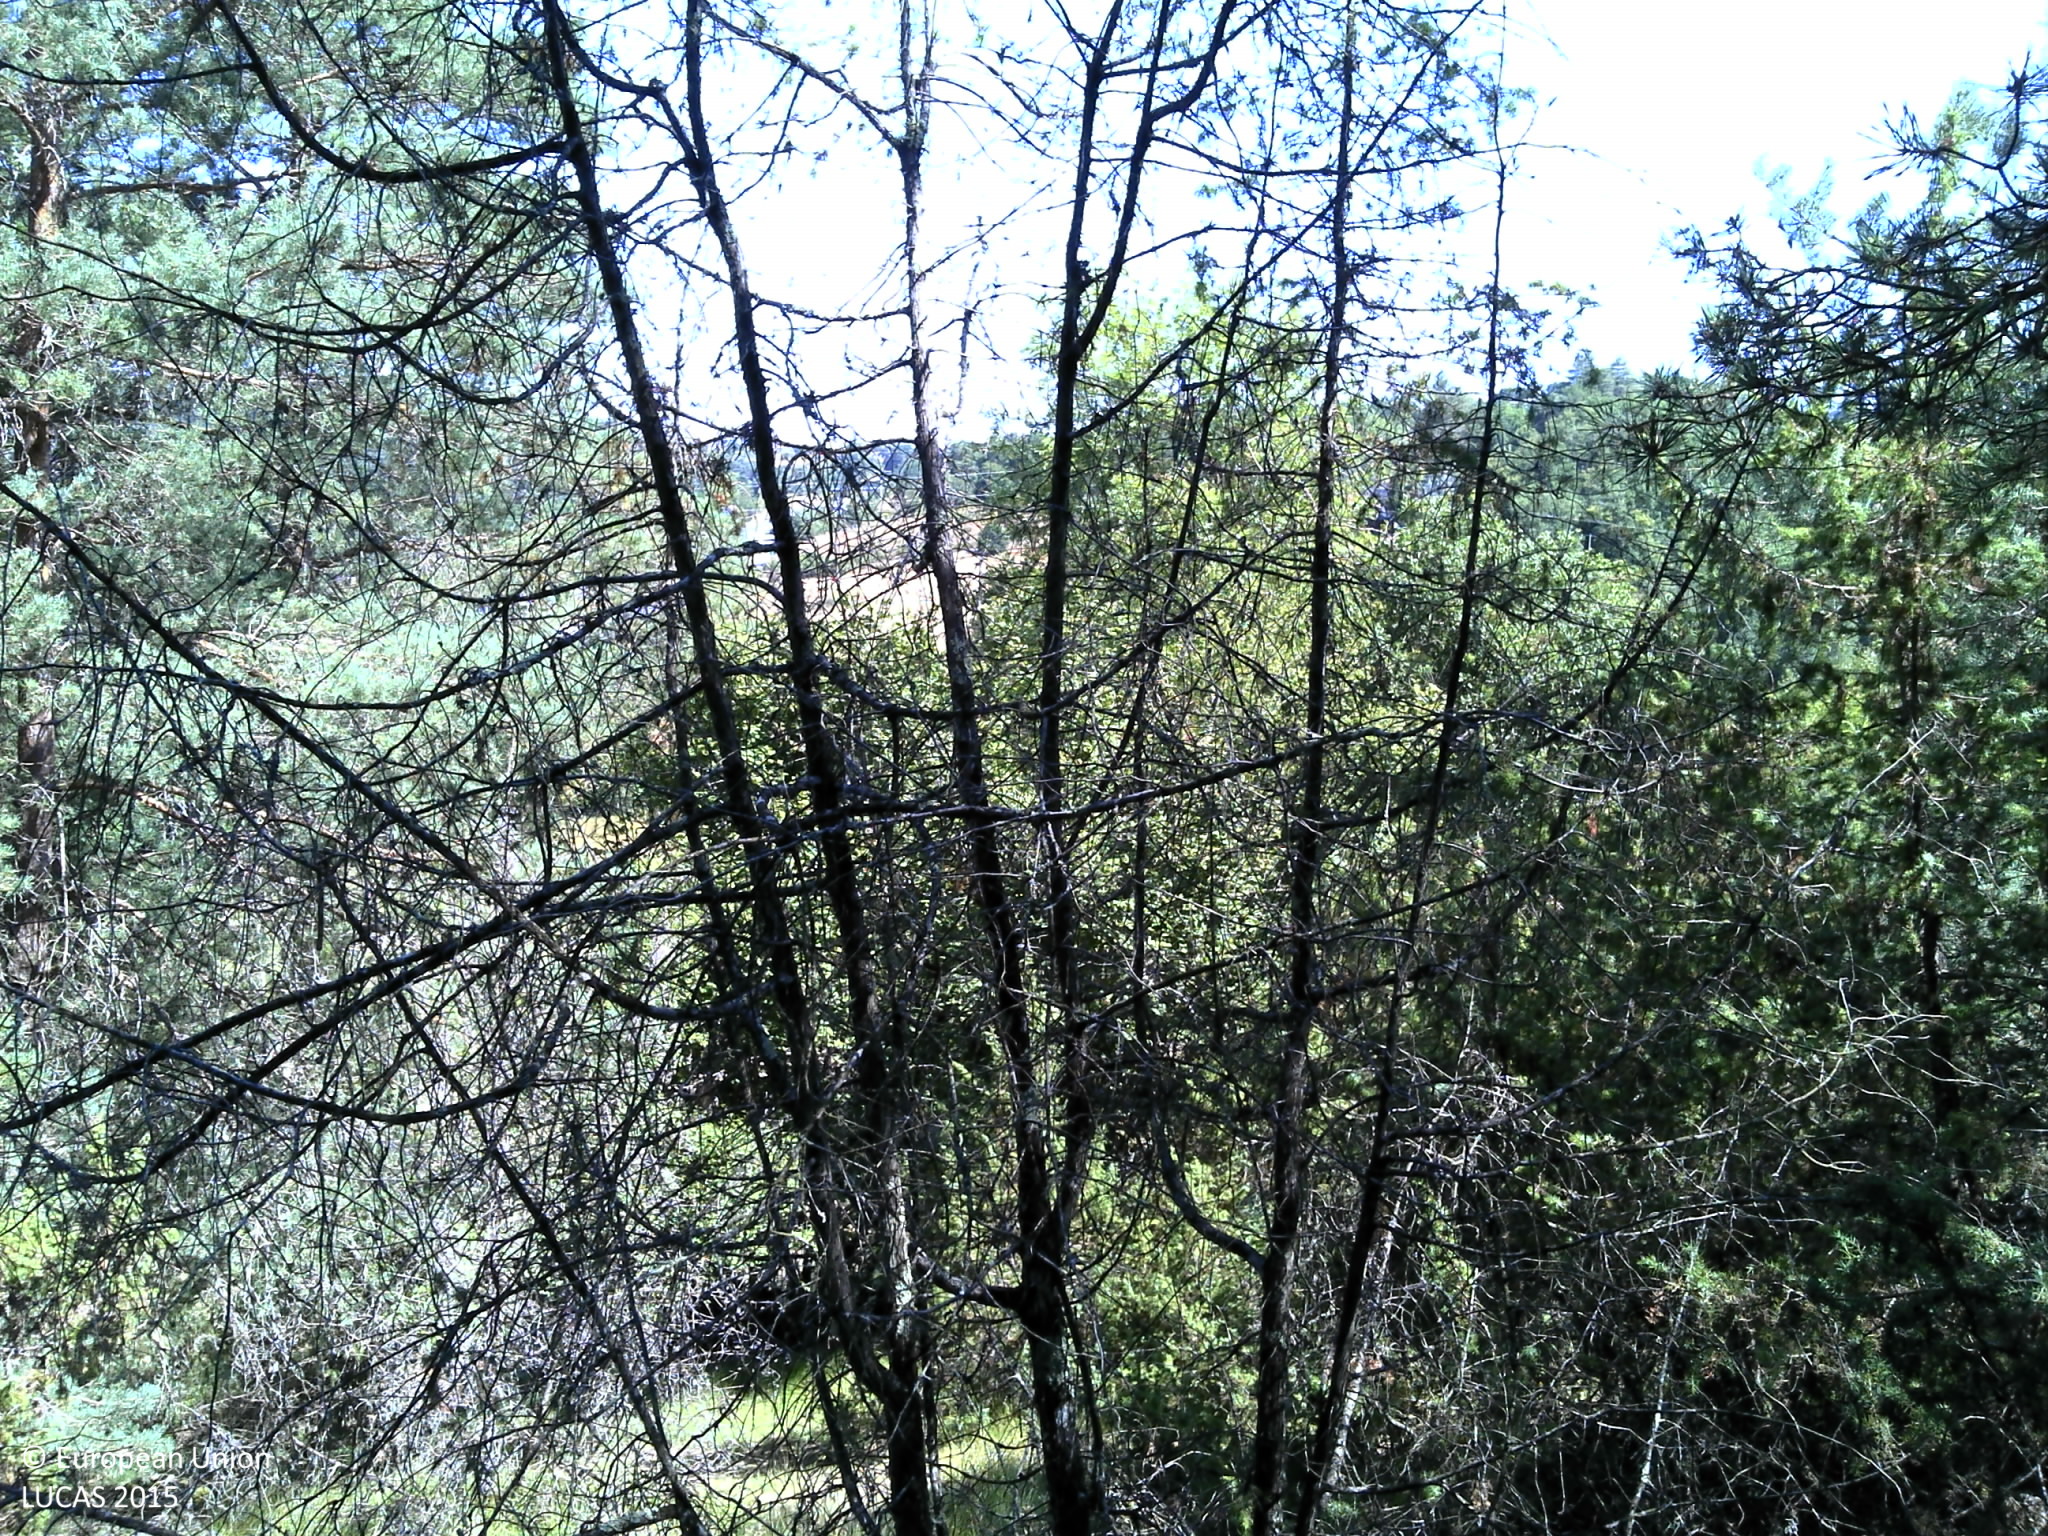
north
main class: Woodland
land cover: Pine dominated mixed woodland
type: thermophilous deciduous forest
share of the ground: > 75 %
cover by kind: coniferous forest trees 35 %, broadleaved forest trees 30 %, herbaceous plants 30 %, unconsolidated bare surface 5 %
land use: Forestry
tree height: > 5 m
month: July
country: FR
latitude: 45.0904
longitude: 1.5207
